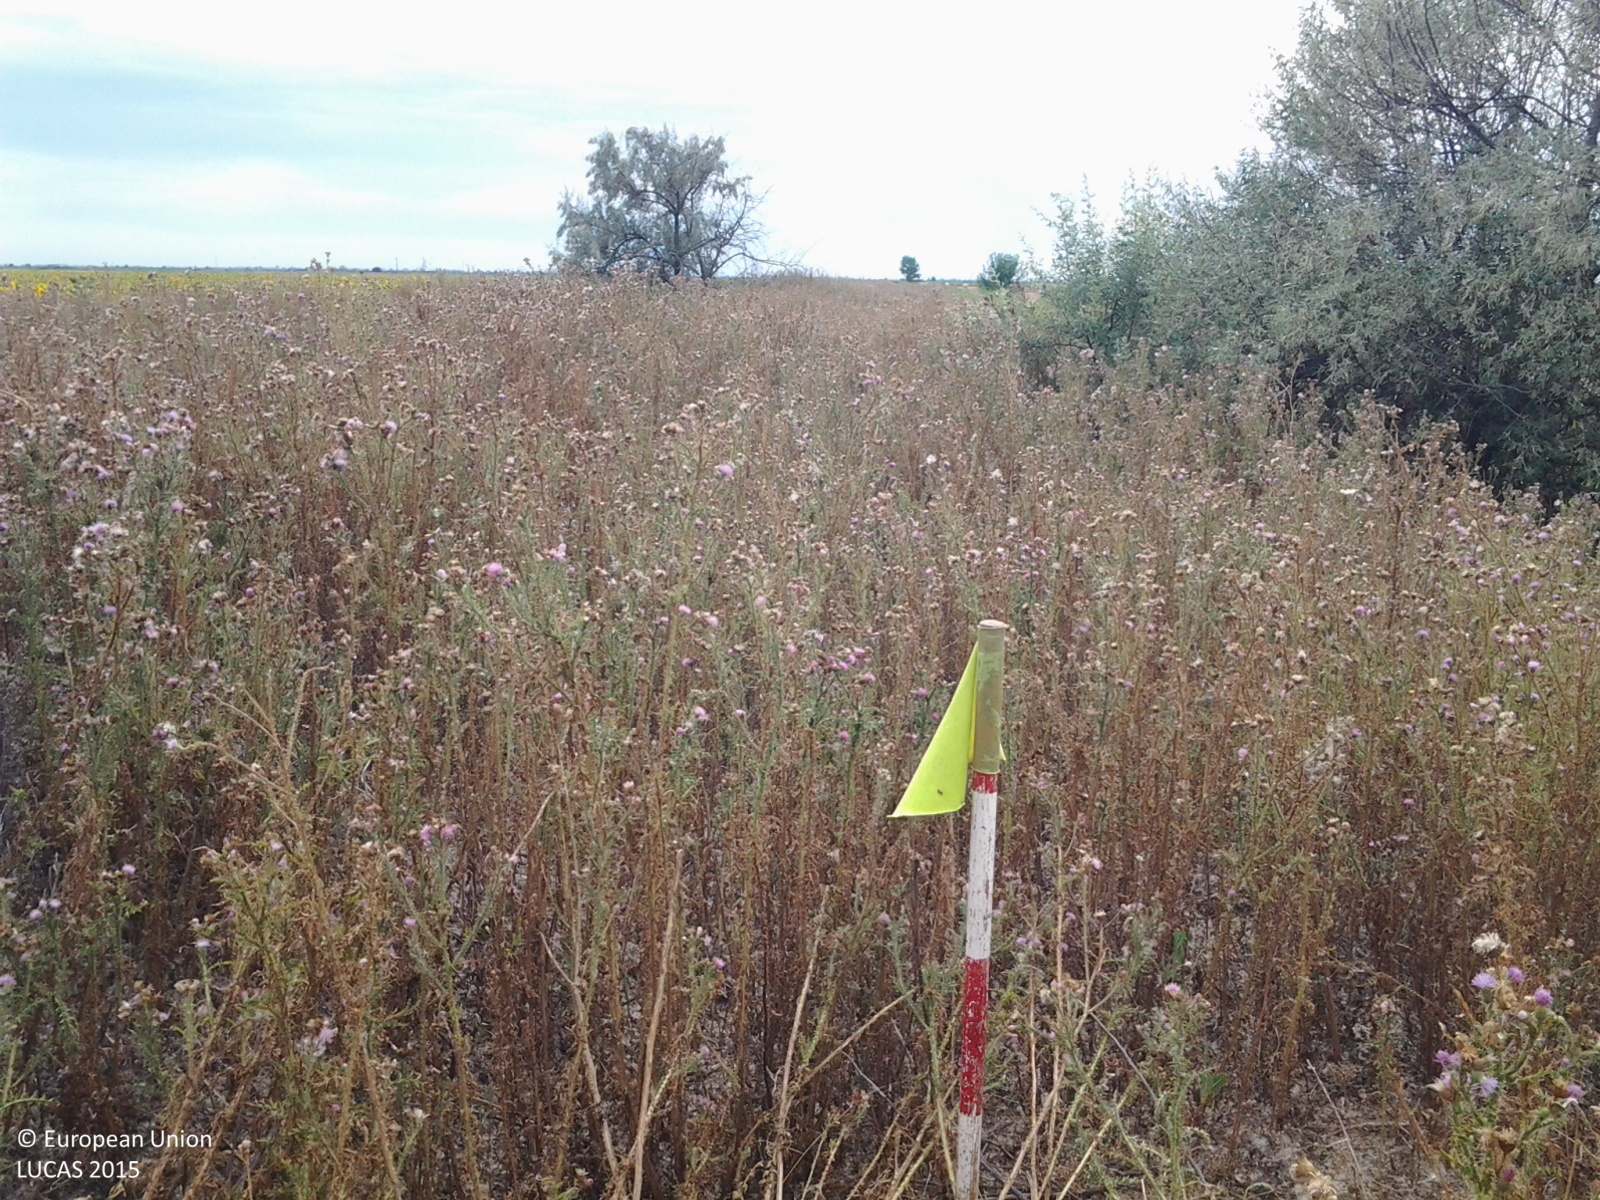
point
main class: Grassland
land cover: Spontaneously vegetated surfaces
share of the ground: > 75 %
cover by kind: herbaceous plants 100 %
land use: Semi-natural and natural areas not in use
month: July
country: HU
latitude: 47.2297
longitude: 20.8775
